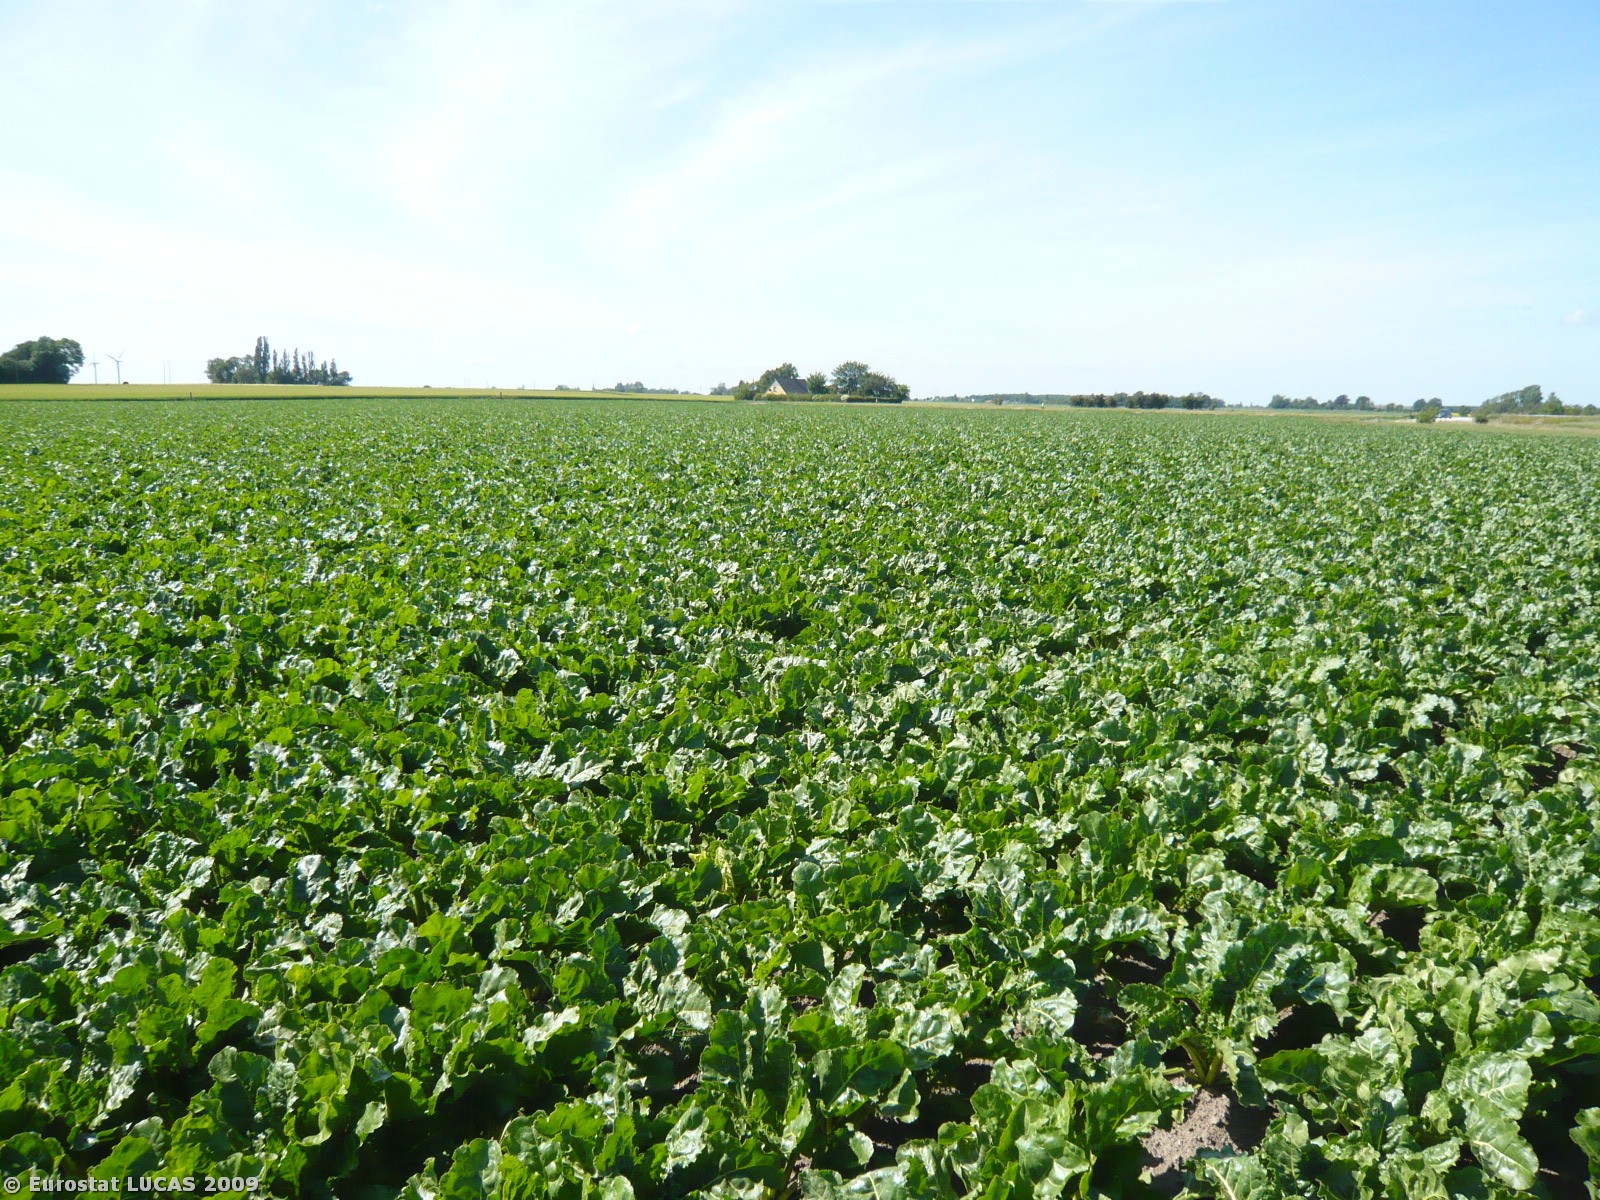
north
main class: Cropland
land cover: Sugar beet
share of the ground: > 75 %
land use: Agriculture (excluding fallow land and kitchen gardens)
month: June
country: DK
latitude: 54.7980
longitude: 11.1969
